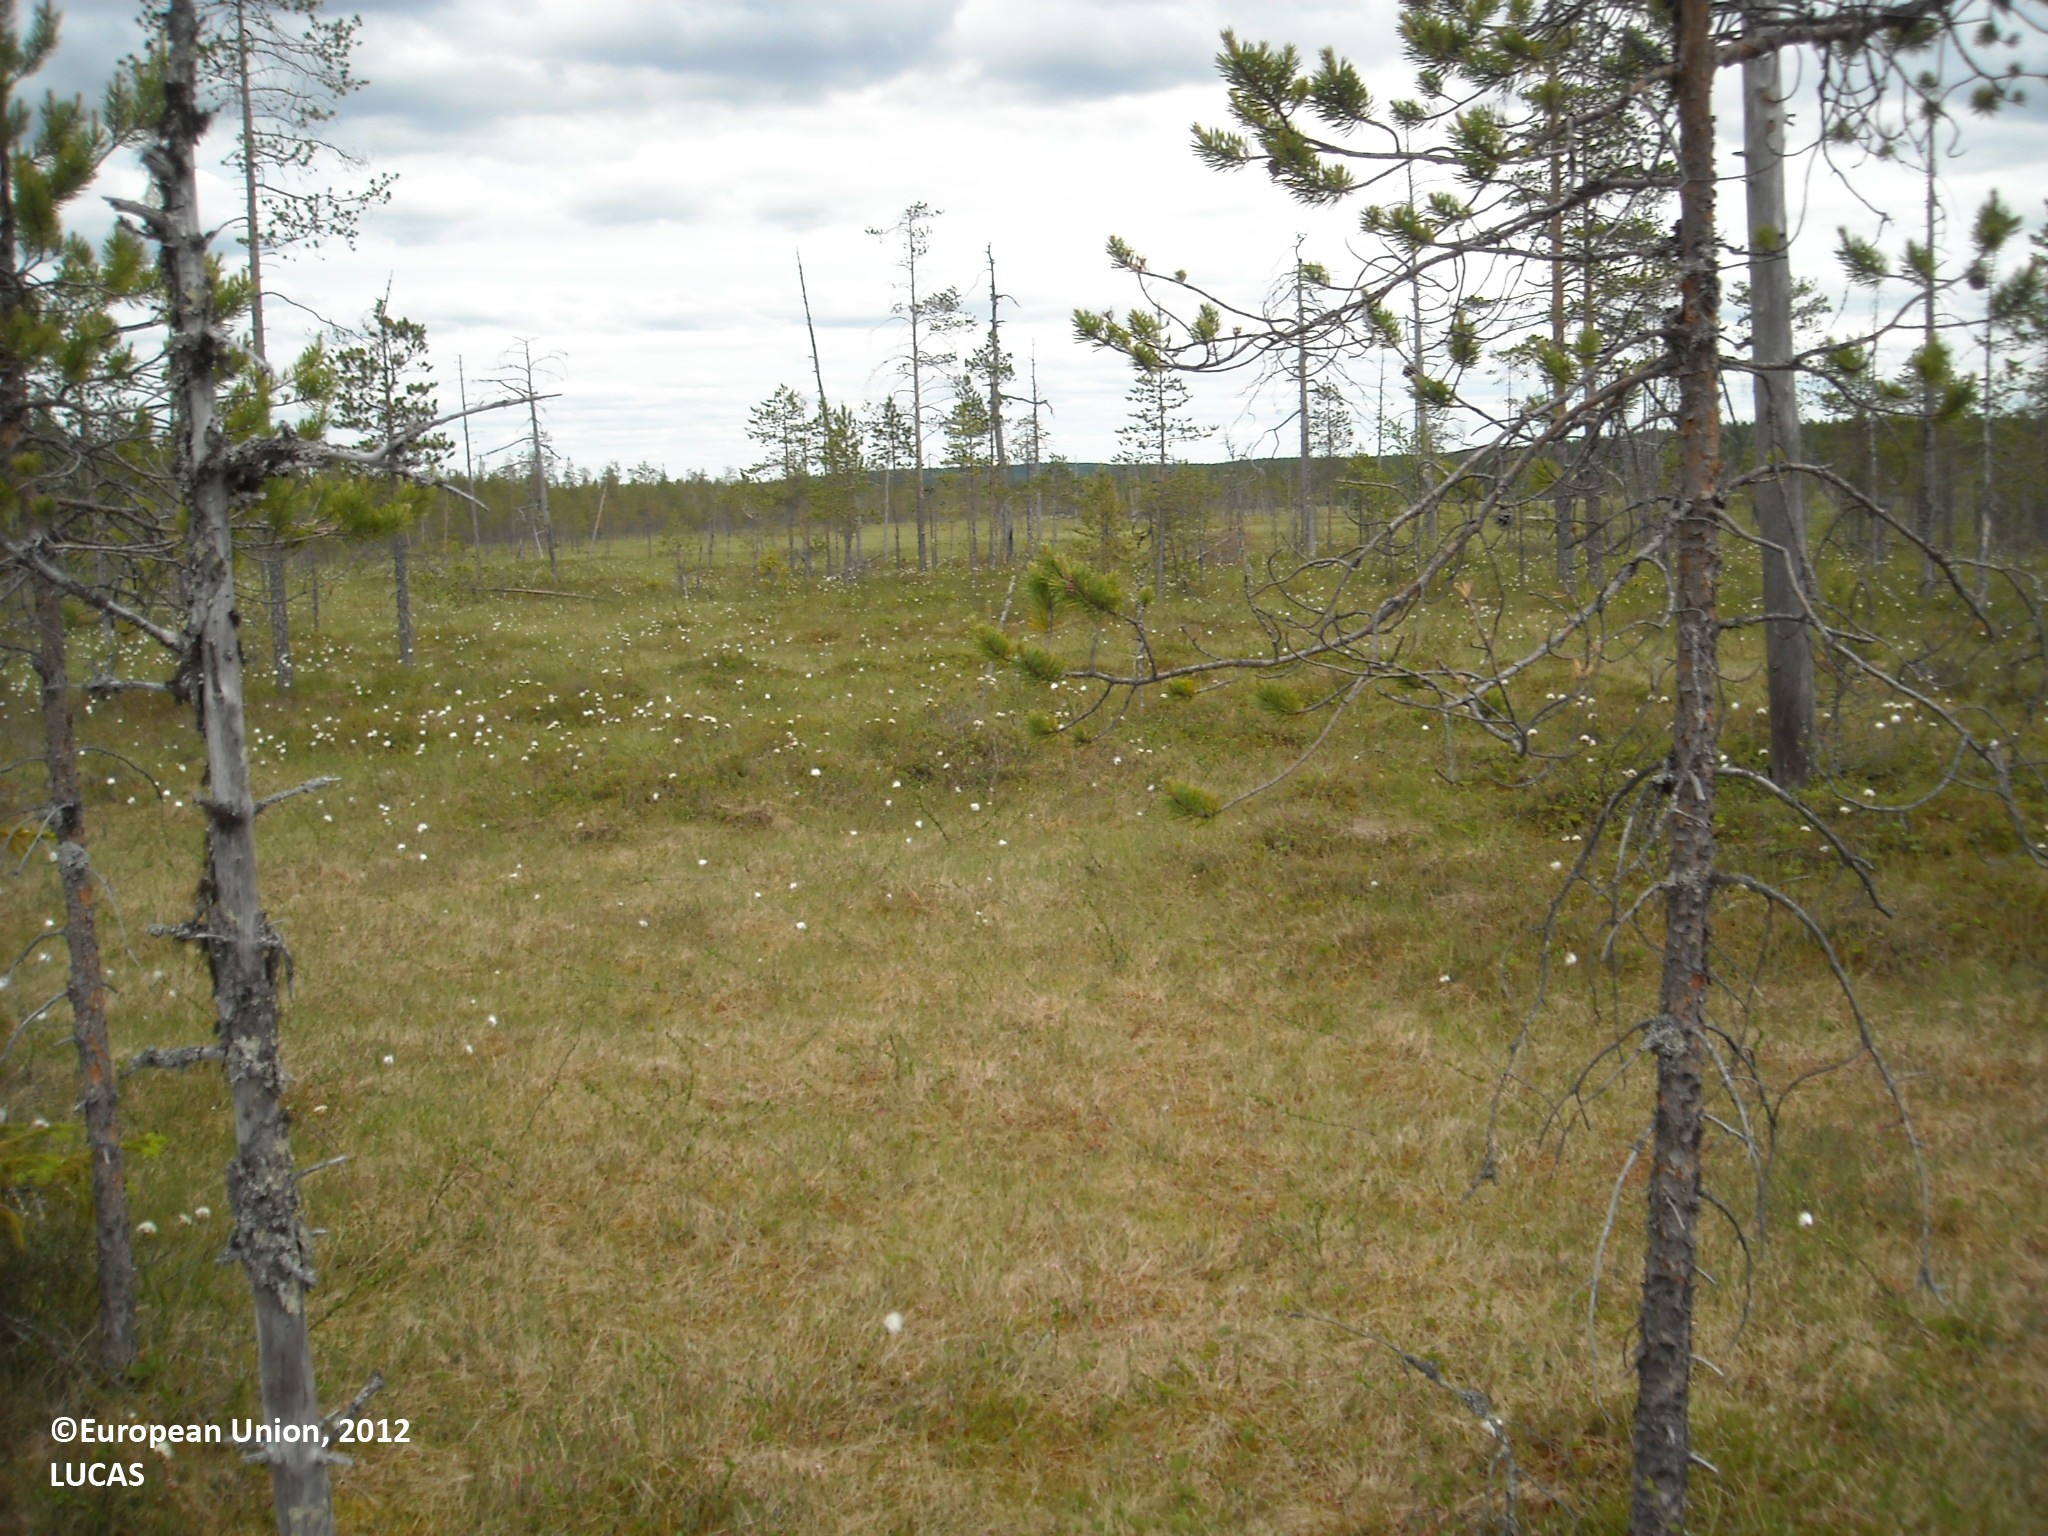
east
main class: Woodland
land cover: Pine dominated coniferous woodland
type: mire and swamp forests
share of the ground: 10 - 25 %
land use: Semi-natural and natural areas not in use
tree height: > 5 m
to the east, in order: Pine dominated coniferous woodland; Peatbogs; Pine dominated coniferous woodland; Peatbogs; Pine dominated coniferous woodland
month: June
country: FI
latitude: 64.8843
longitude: 27.9961
